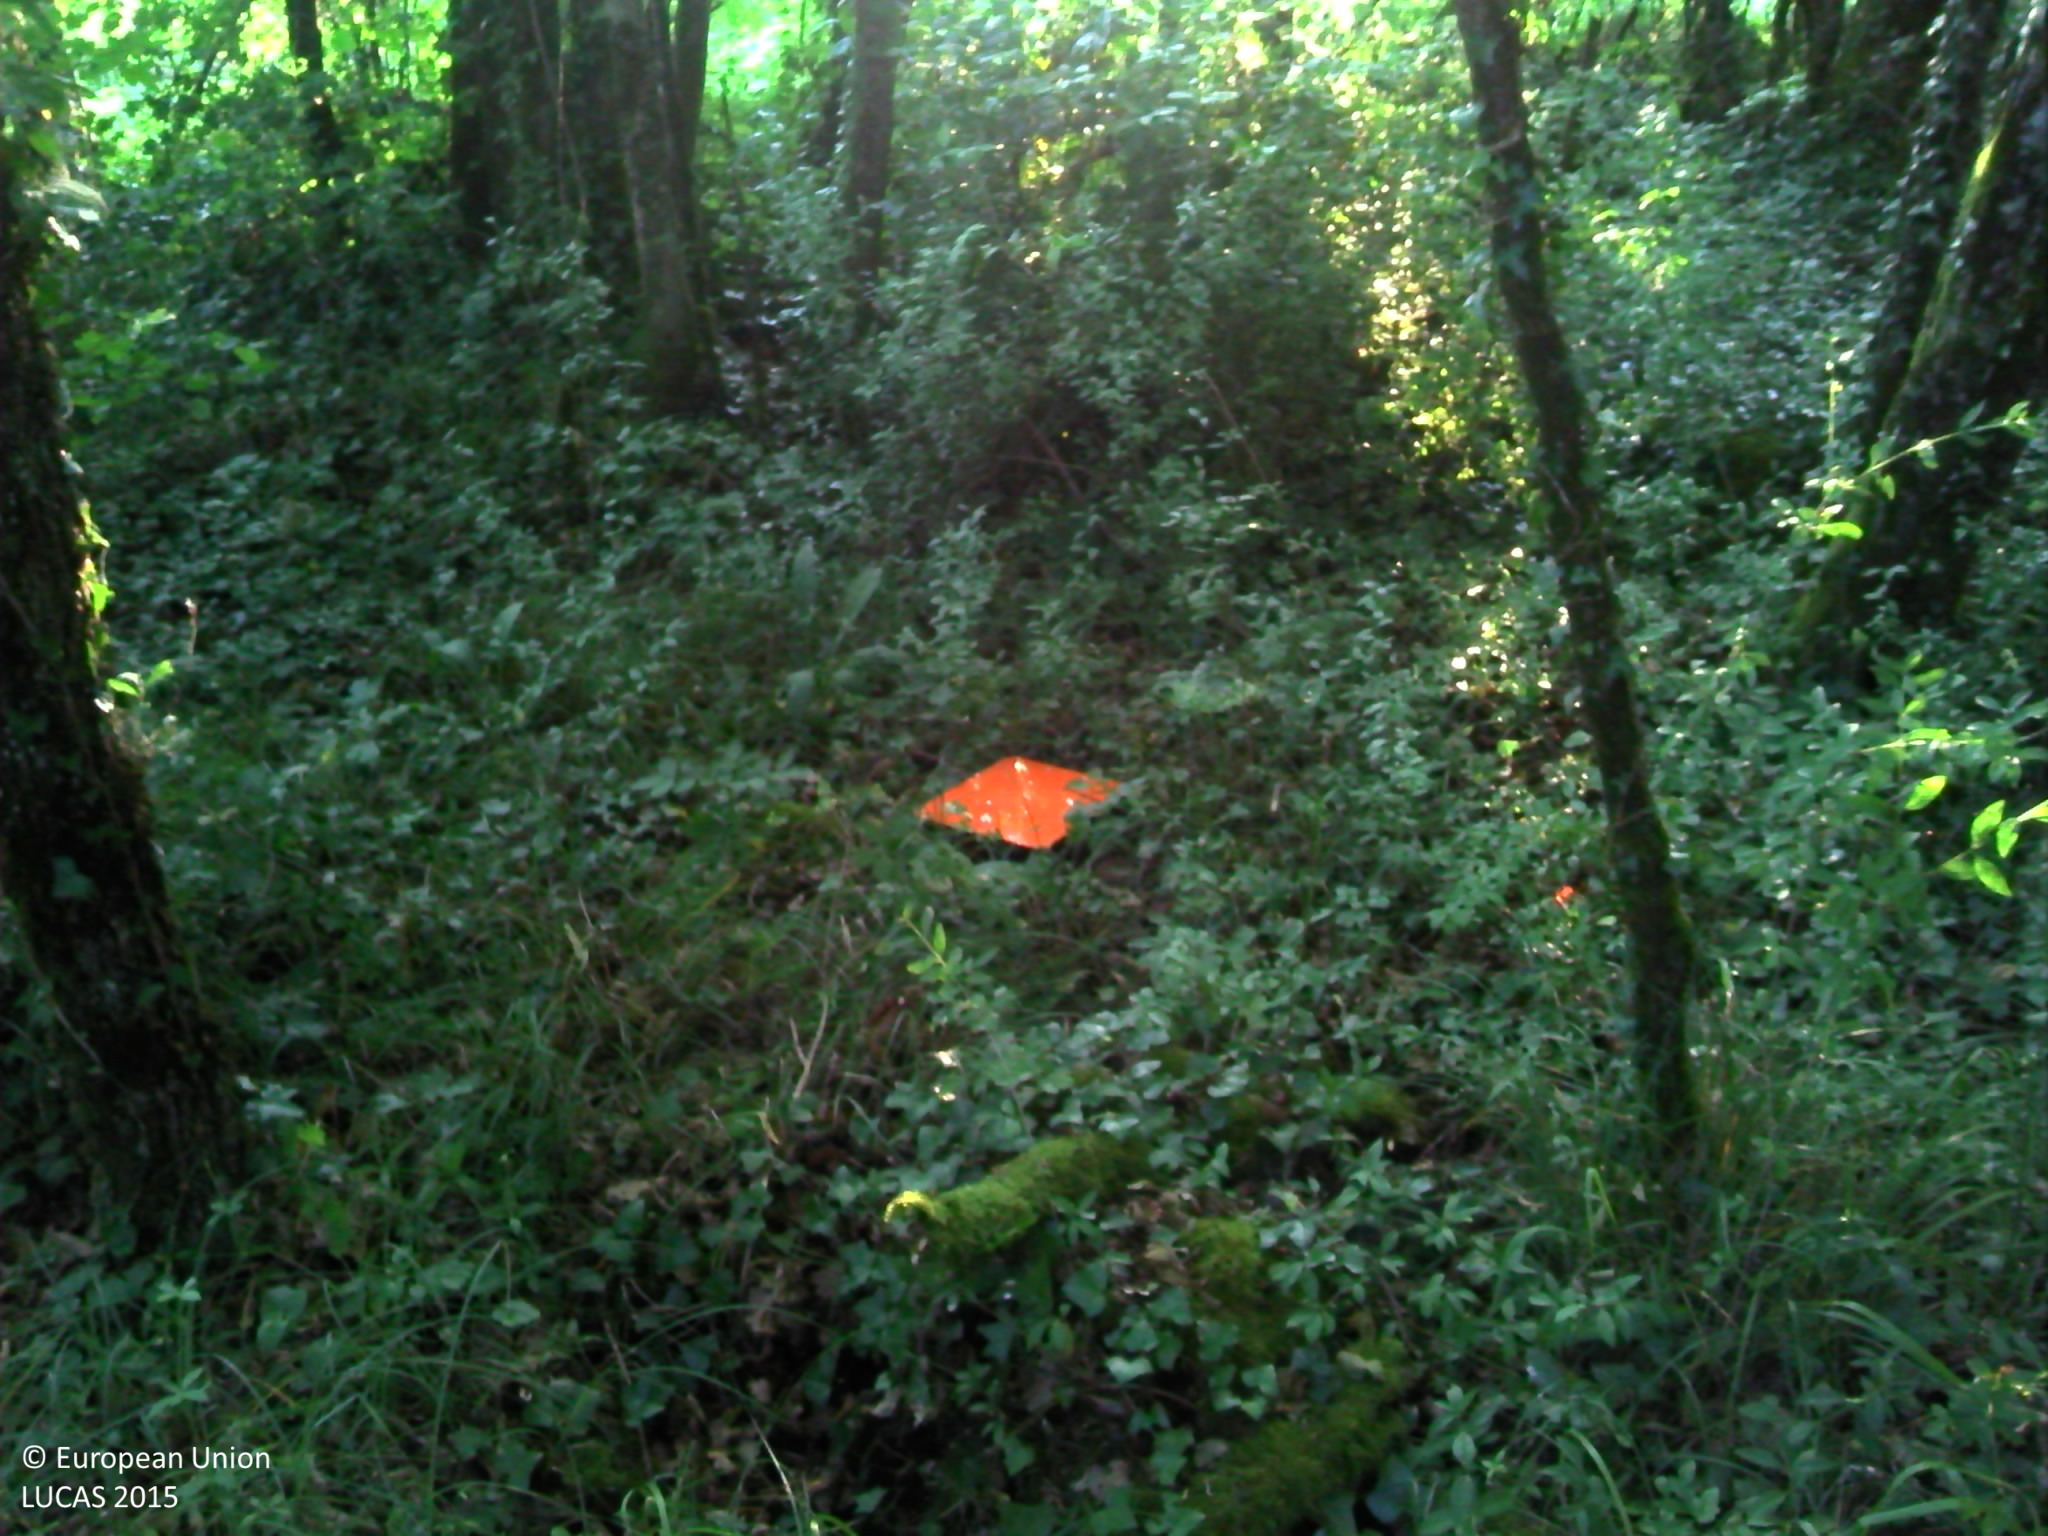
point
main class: Woodland
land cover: Broadleaved woodland
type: mesophytic deciduous forest
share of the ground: > 75 %
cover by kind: broadleaved forest trees 85 %, shrubs 10 %, herbaceous plants 5 %
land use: Forestry
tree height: > 5 m
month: June
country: FR
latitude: 46.6781
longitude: 0.5830
